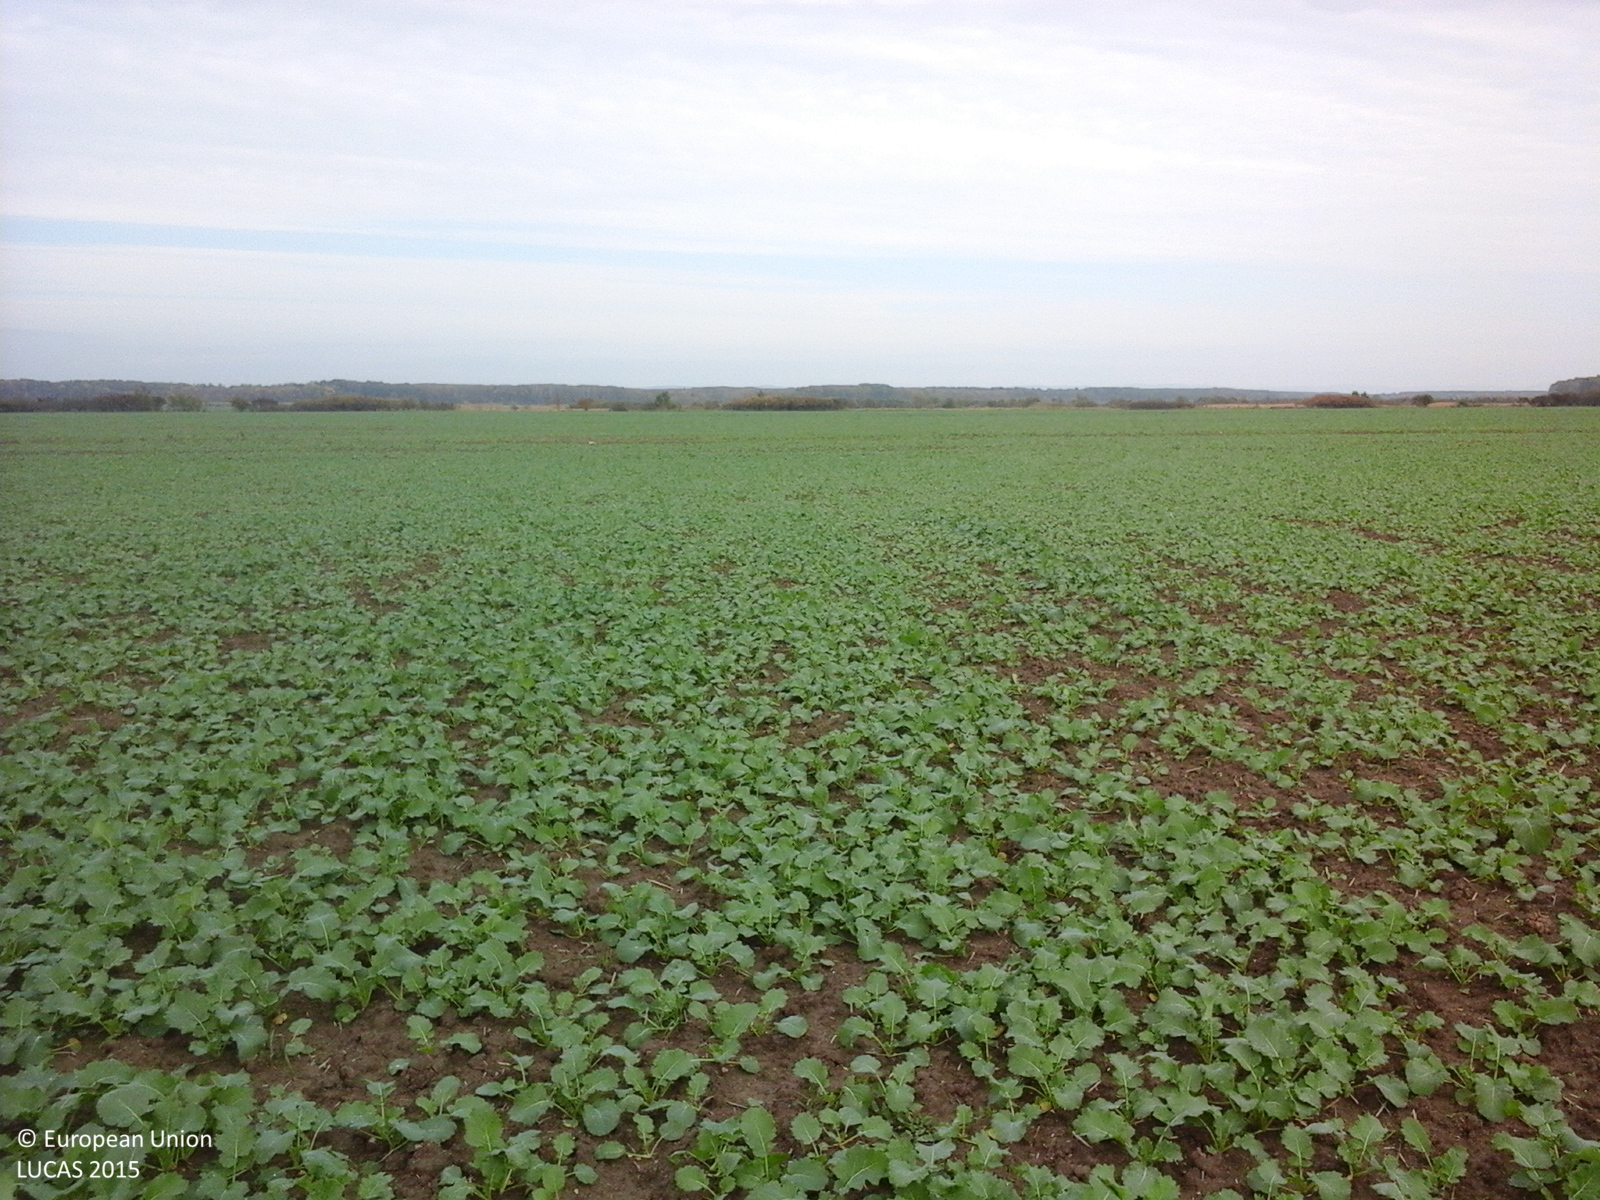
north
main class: Cropland
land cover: Rape and turnip rape
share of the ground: > 75 %
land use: Agriculture (excluding fallow land and kitchen gardens)
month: October
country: RO
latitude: 44.8049
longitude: 26.1282
